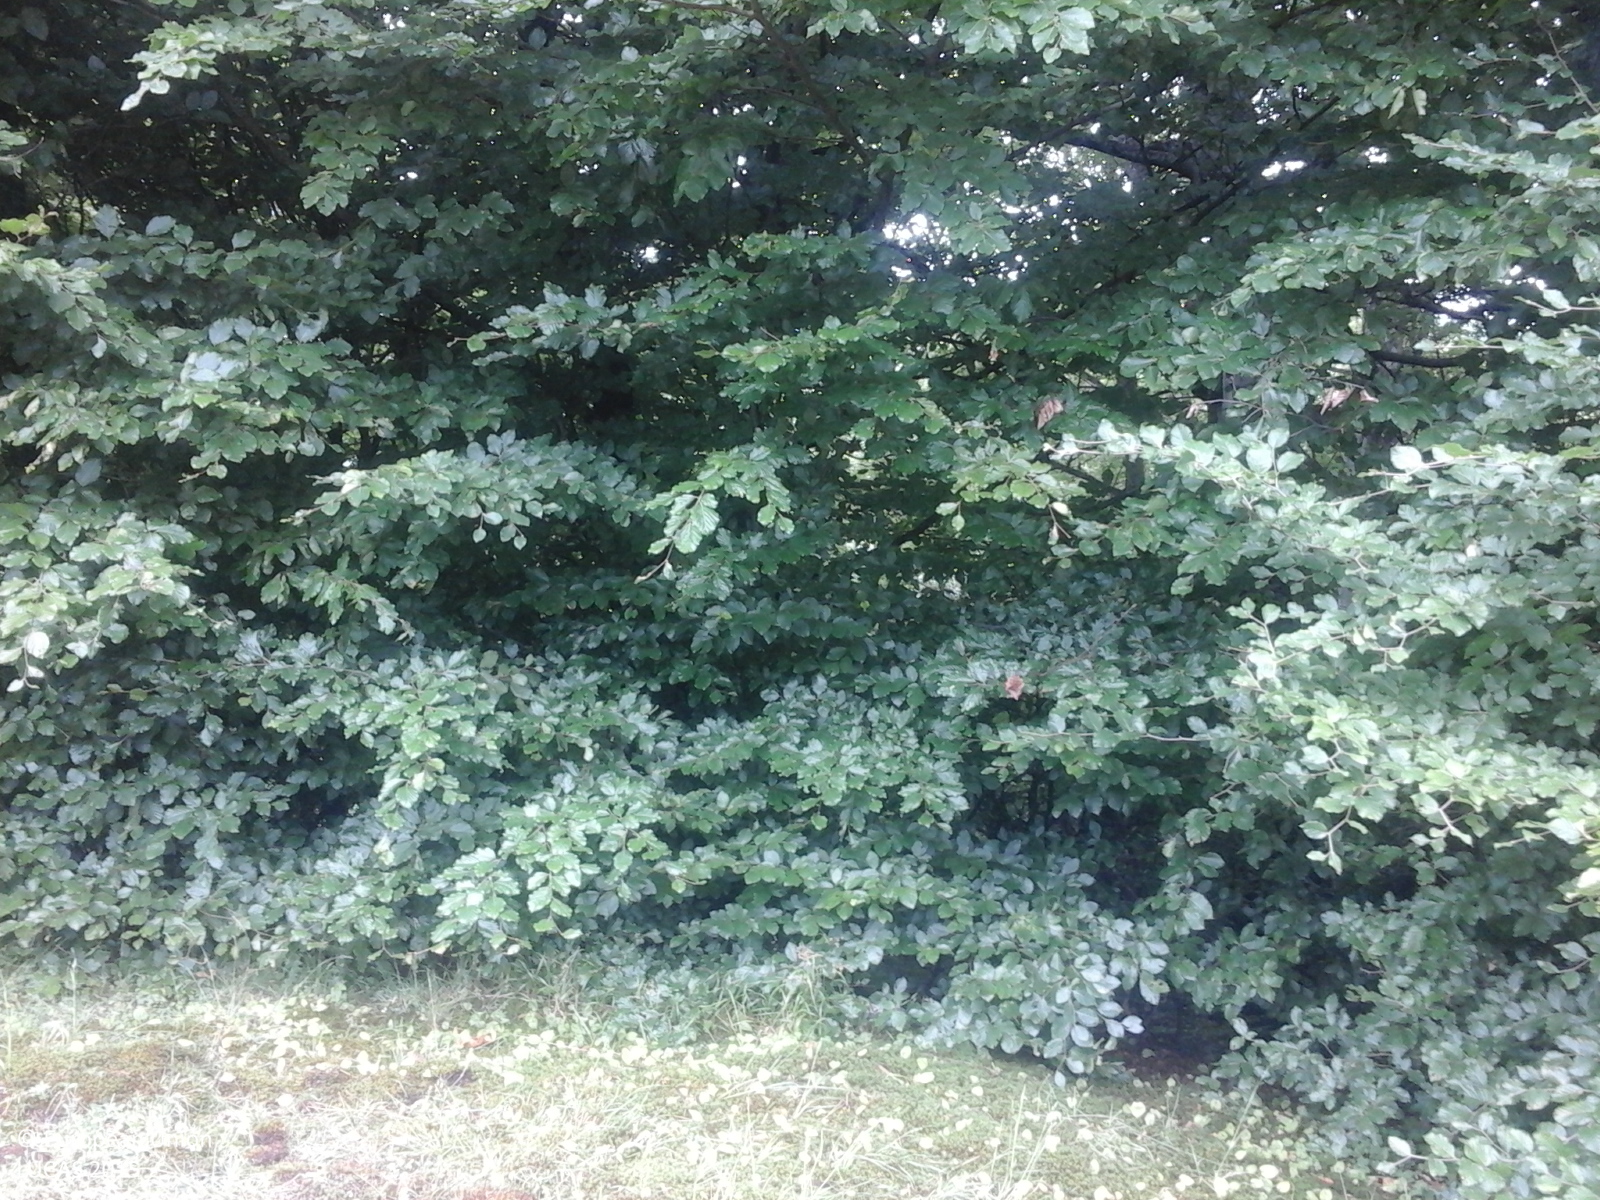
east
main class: Woodland
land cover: Broadleaved woodland
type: beech forest
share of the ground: > 75 %
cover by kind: broadleaved forest trees 100 %
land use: Forestry
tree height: > 5 m
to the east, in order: Broadleaved woodland; Grassland with sparse tree/shrub cover; Ditches and canals; Grassland without tree/shrub cover; Fences; Grassland with sparse tree/shrub cover; Inland fresh running water
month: July
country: RO
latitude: 45.3510
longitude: 24.8013
